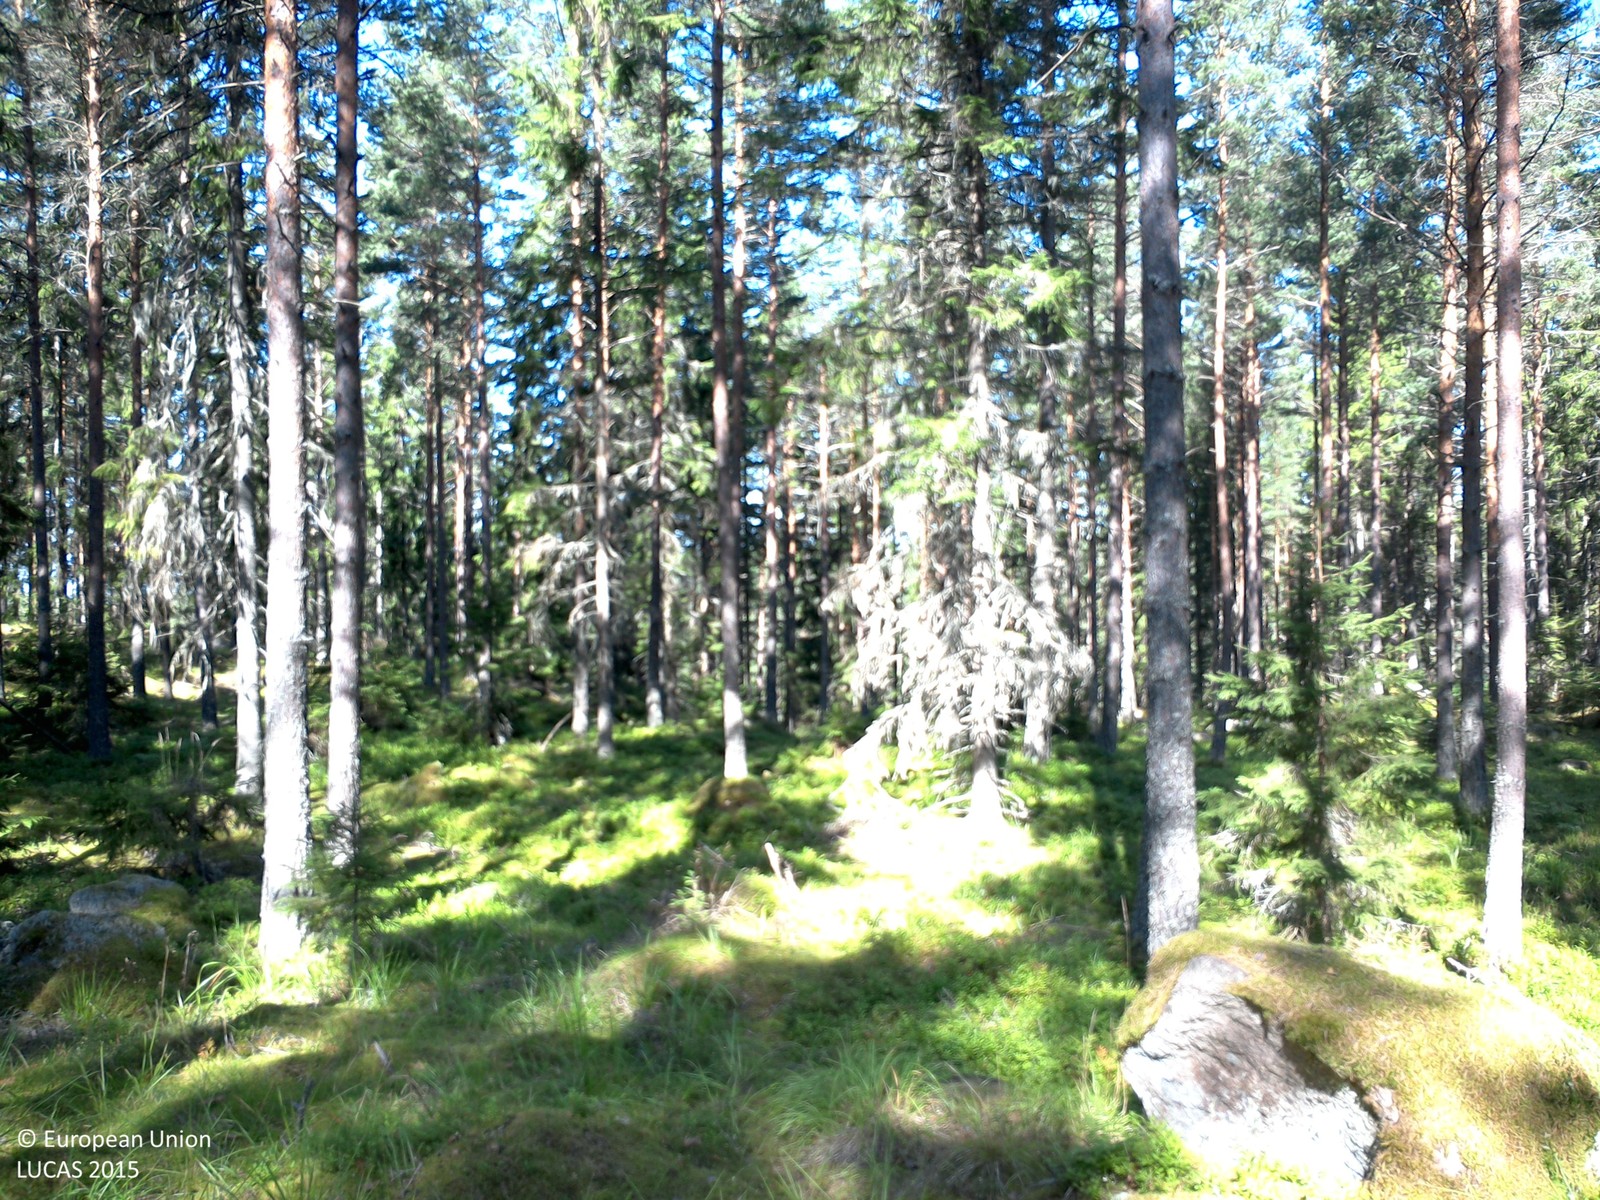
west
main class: Woodland
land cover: Pine dominated coniferous woodland
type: boreal forest
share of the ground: 50 - 75 %
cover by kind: coniferous forest trees 50 %, herbaceous plants 20 %, lichens and mosses 20 %, shrubs 10 %
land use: Forestry
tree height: > 5 m
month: August
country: SE
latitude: 57.8550
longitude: 15.9114
